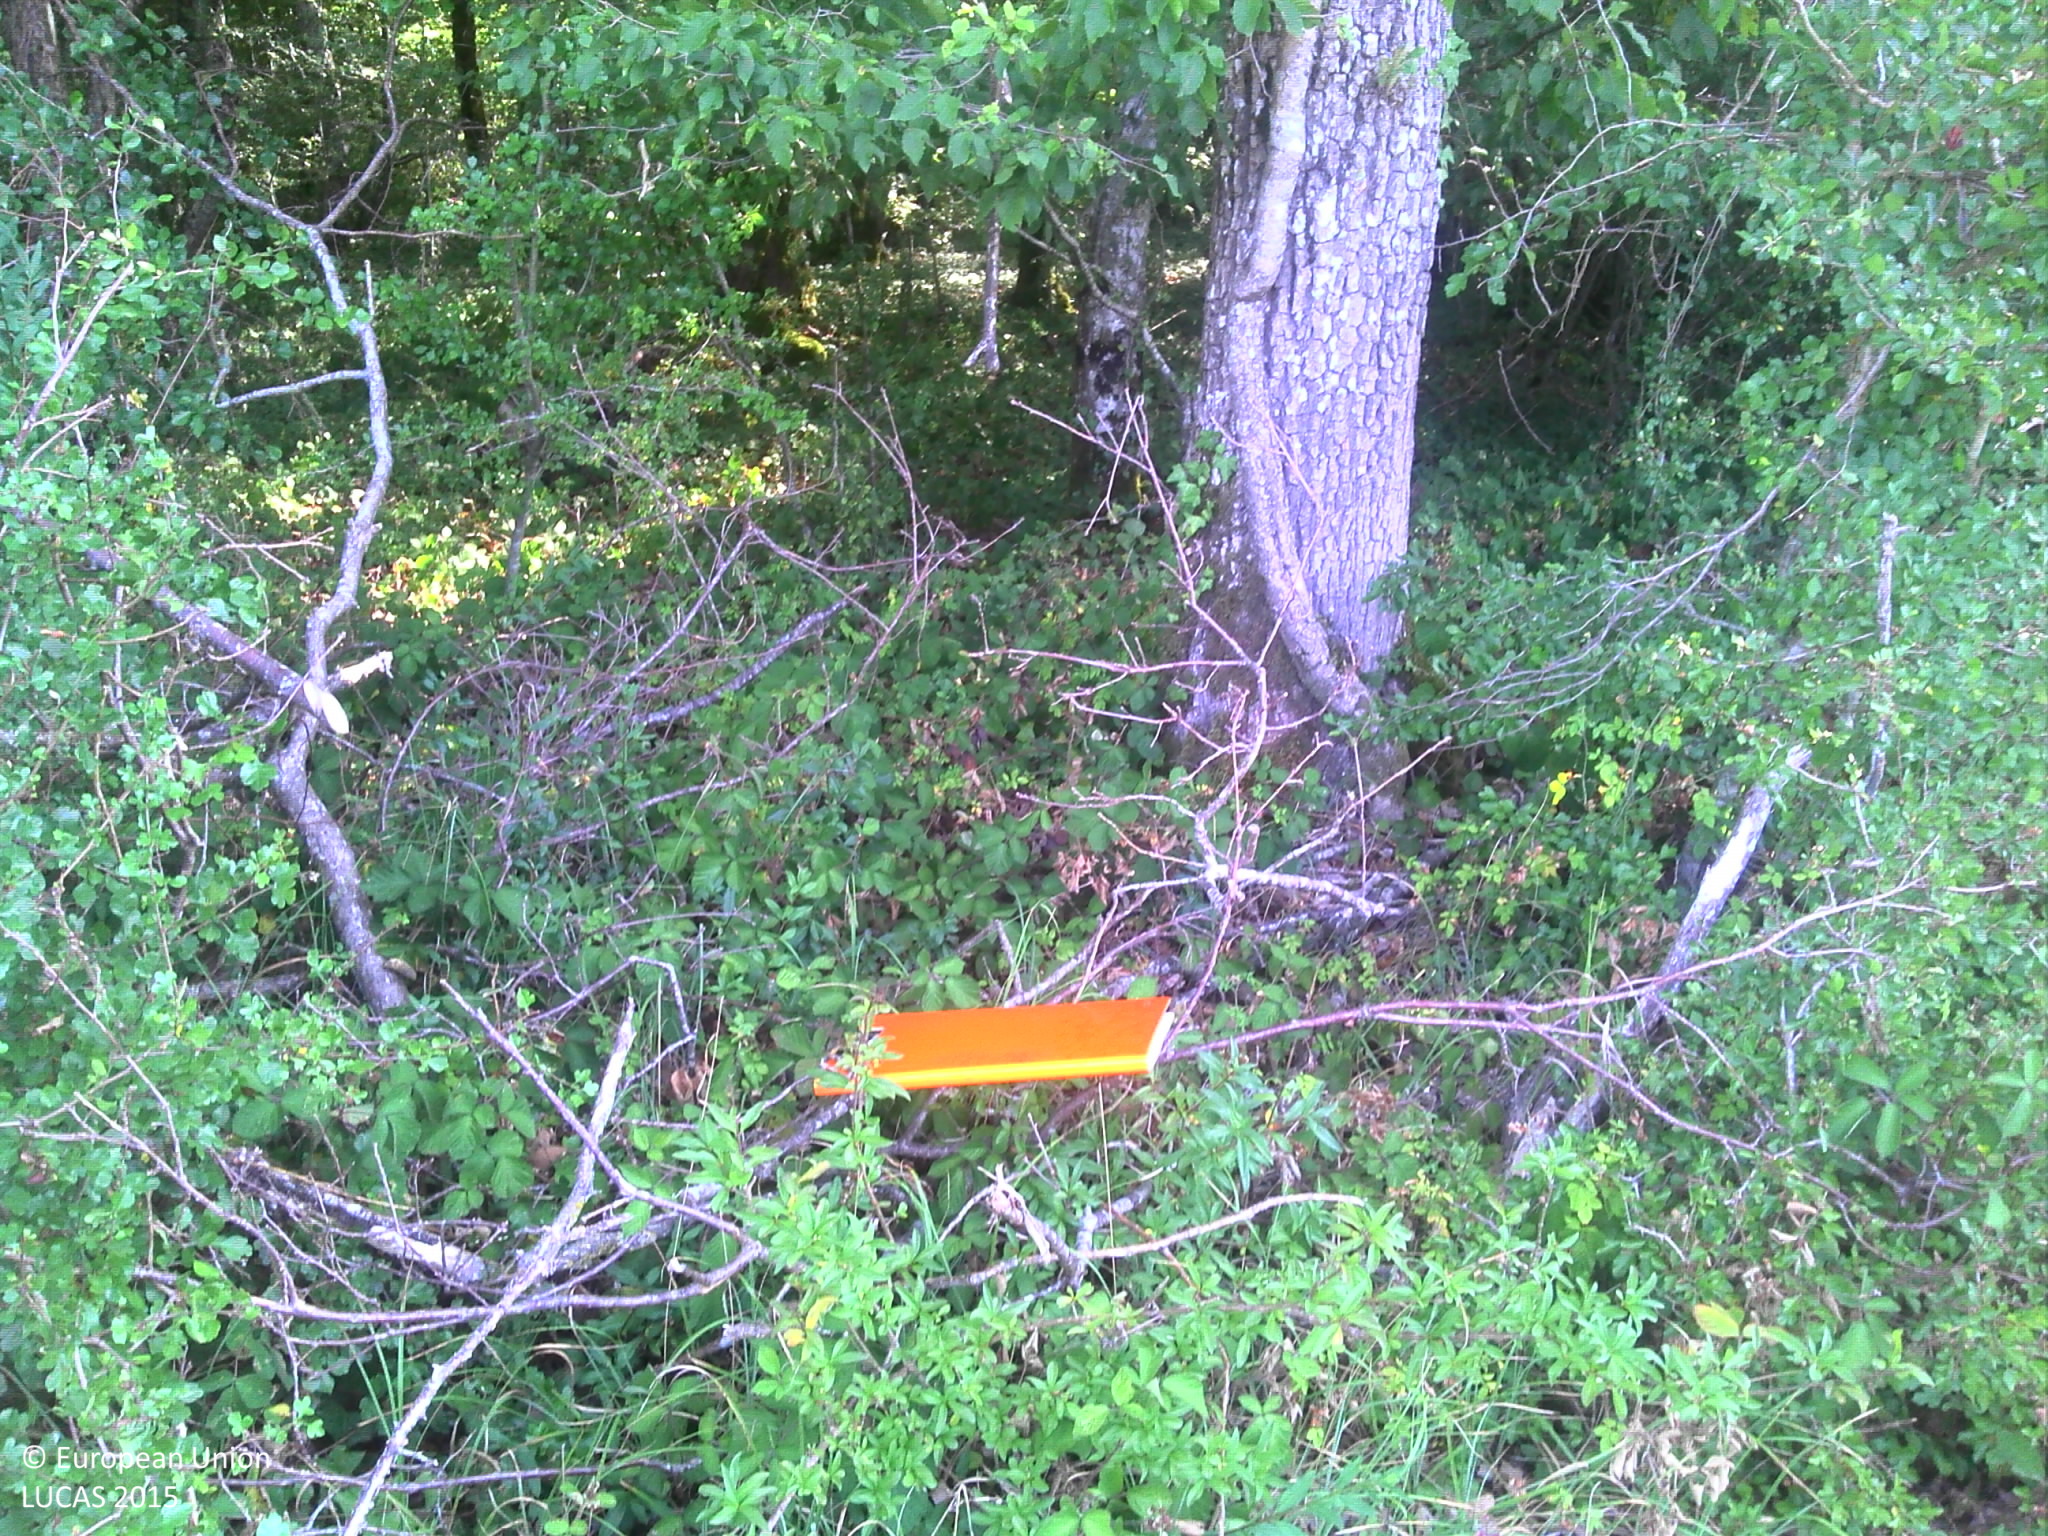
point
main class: Woodland
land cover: Broadleaved woodland
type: mesophytic deciduous forest
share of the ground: > 75 %
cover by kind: broadleaved forest trees 80 %, herbaceous plants 15 %, lichens and mosses 5 %
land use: Forestry
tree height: > 5 m
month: July
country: FR
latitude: 48.0855
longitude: 4.8570
